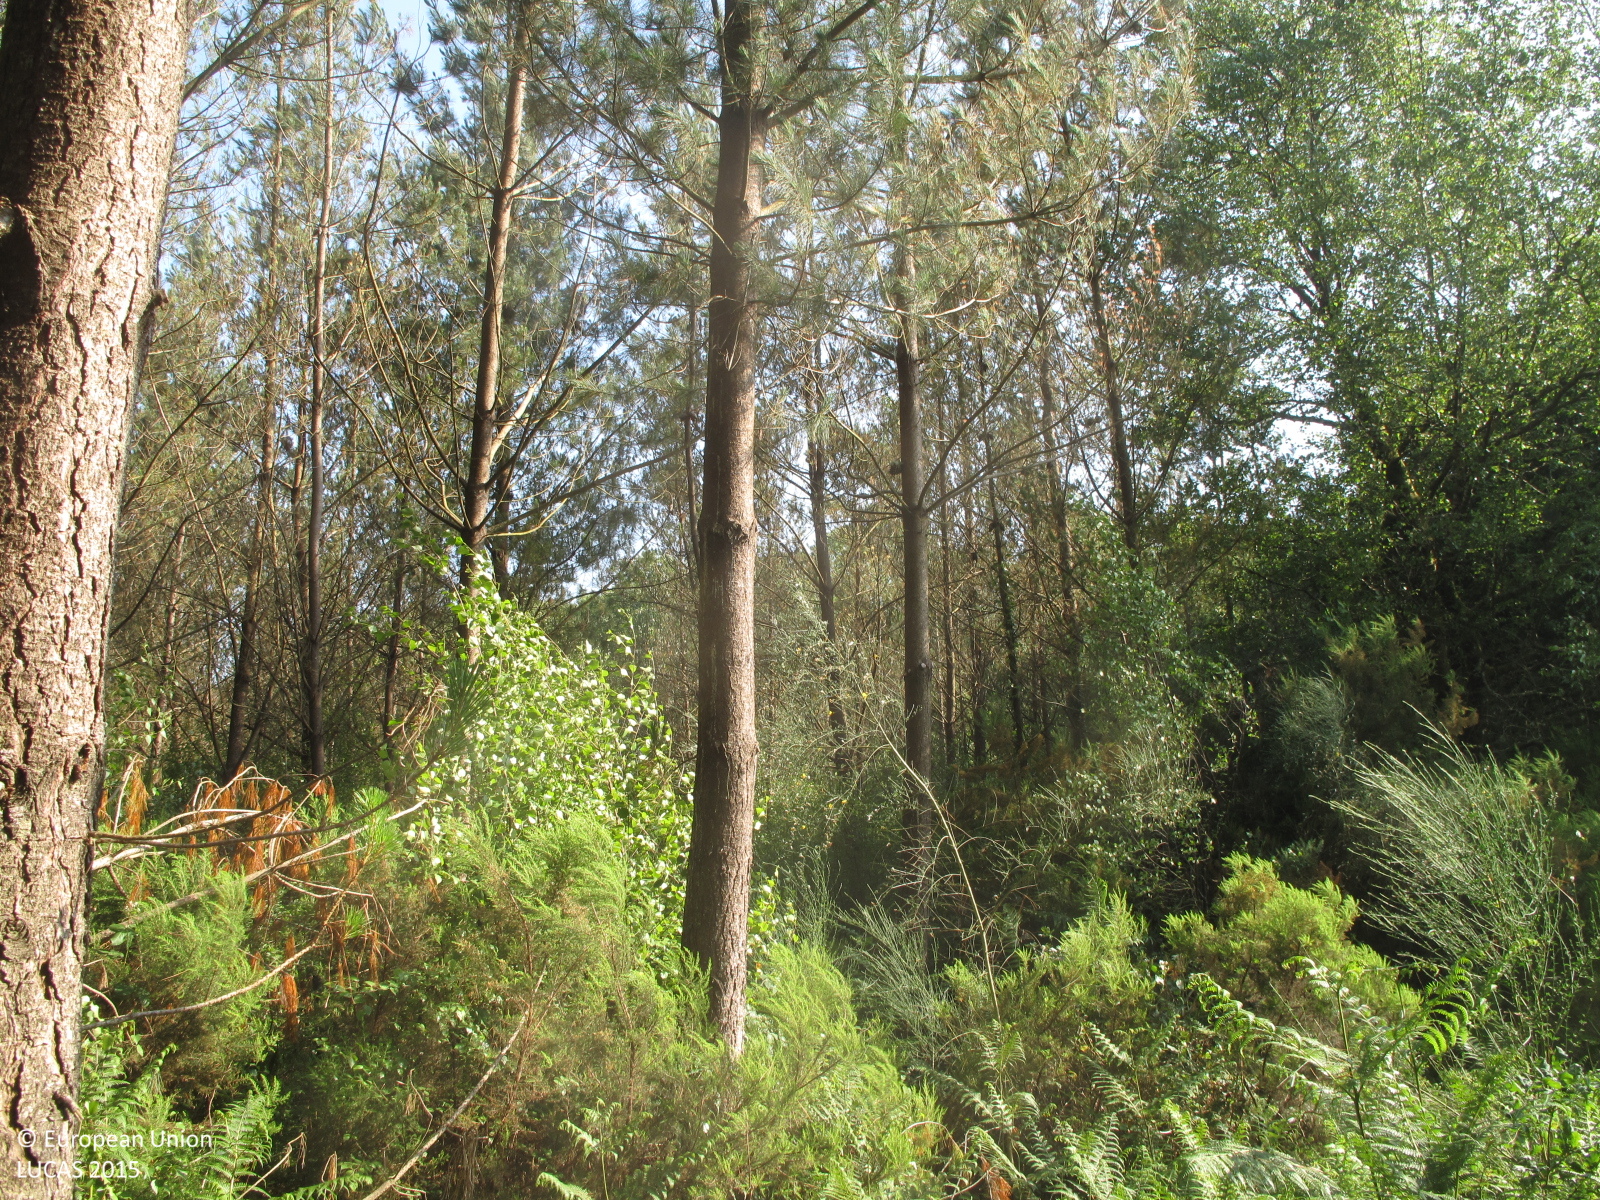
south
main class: Woodland
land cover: Pine dominated coniferous woodland
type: exotic forest
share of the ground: 50 - 75 %
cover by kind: coniferous forest trees 60 %, shrubs 20 %, broadleaved forest trees 10 %, herbaceous plants 10 %
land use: Forestry
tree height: > 5 m
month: June
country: ES
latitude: 43.0197
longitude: -7.8916
